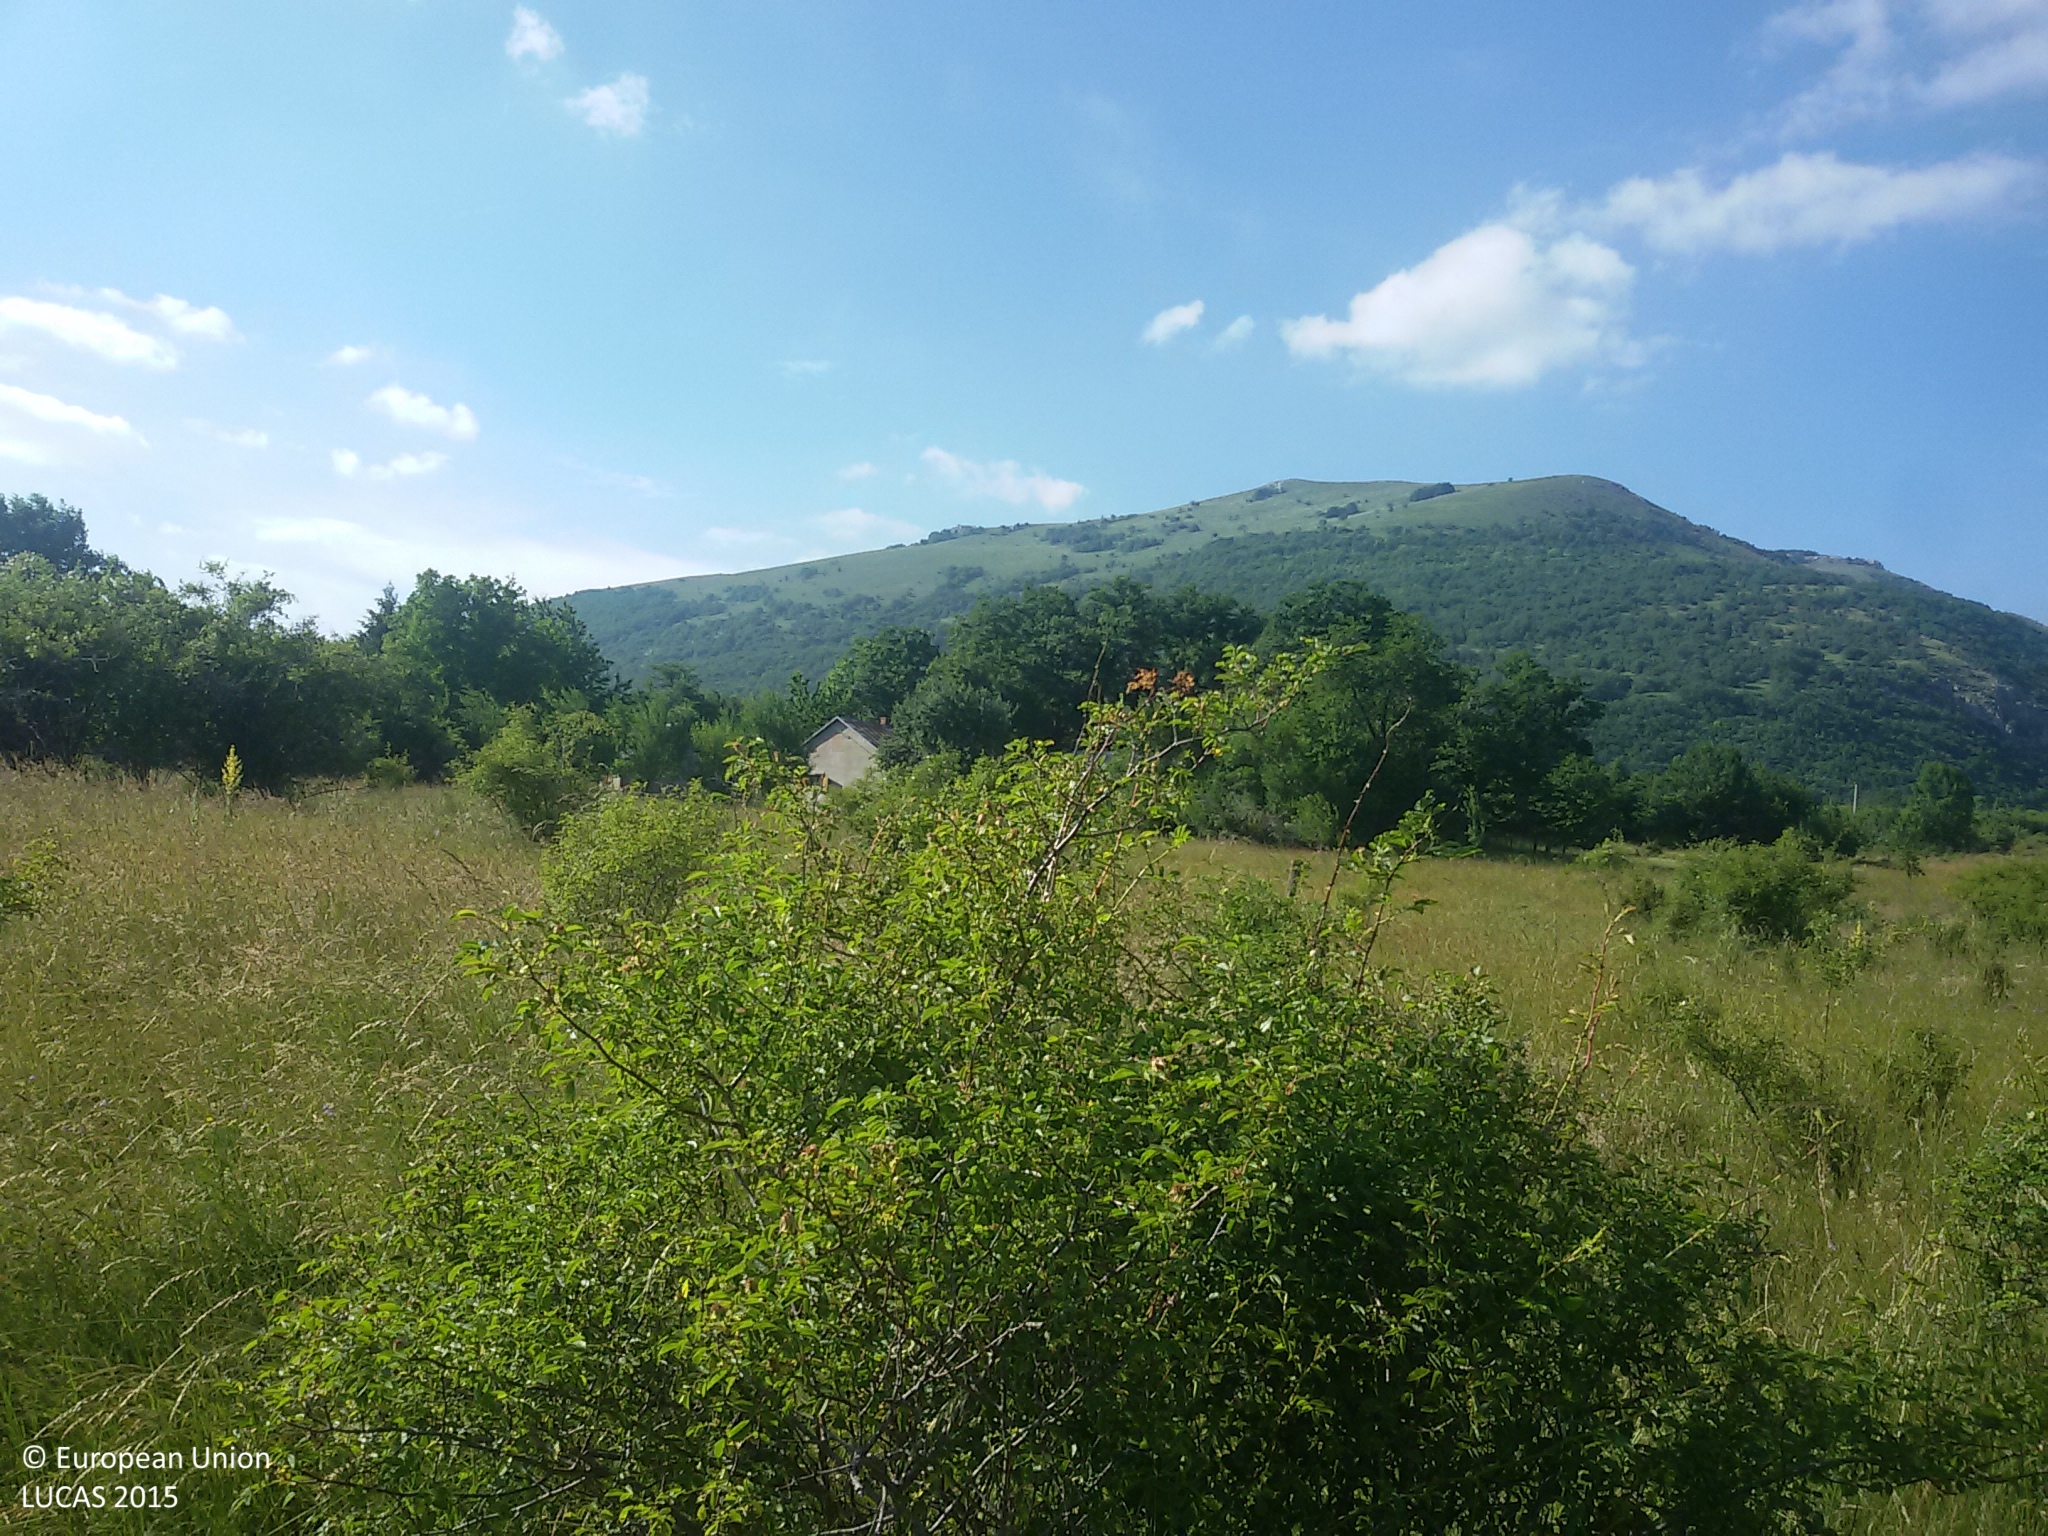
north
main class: Grassland
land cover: Grassland with sparse tree/shrub cover
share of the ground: > 75 %
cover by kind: herbaceous plants 85 %, broadleaved forest trees 5 %, shrubs 5 %, unconsolidated bare surface 5 %
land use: Semi-natural and natural areas not in use
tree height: < 5 m
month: June
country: HR
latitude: 44.5487
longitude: 15.8218
